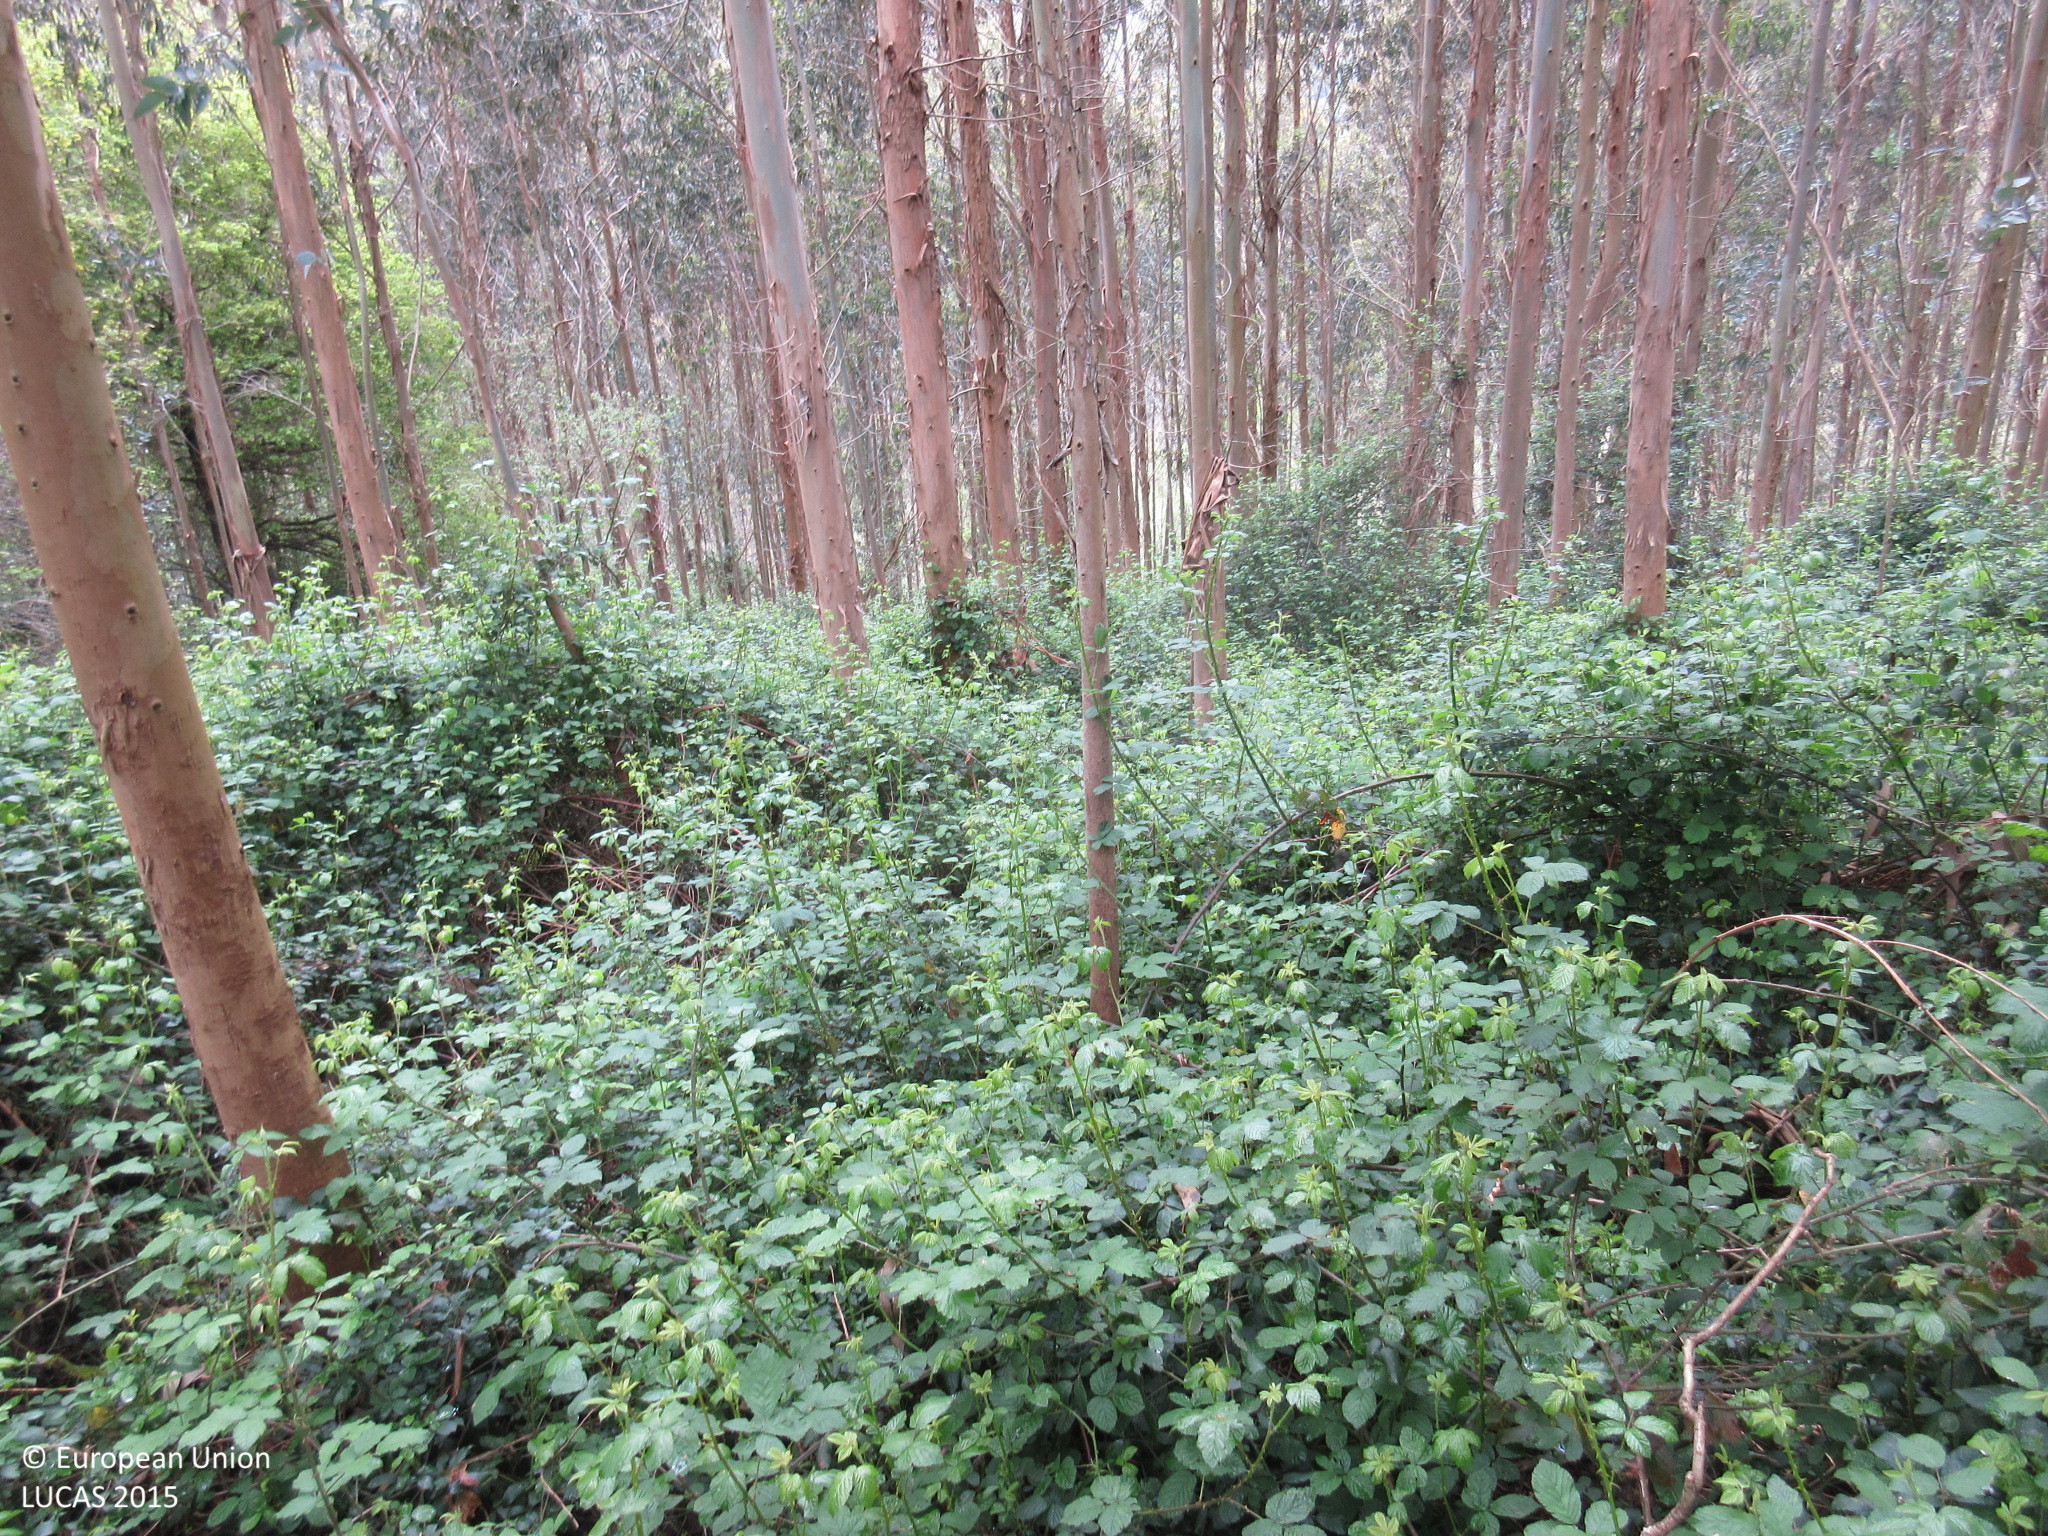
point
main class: Woodland
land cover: Broadleaved woodland
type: exotic forest
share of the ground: > 75 %
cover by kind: broadleaved forest trees 90 %, shrubs 10 %
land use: Forestry
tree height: > 5 m
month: April
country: ES
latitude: 43.4523
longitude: -5.1376
